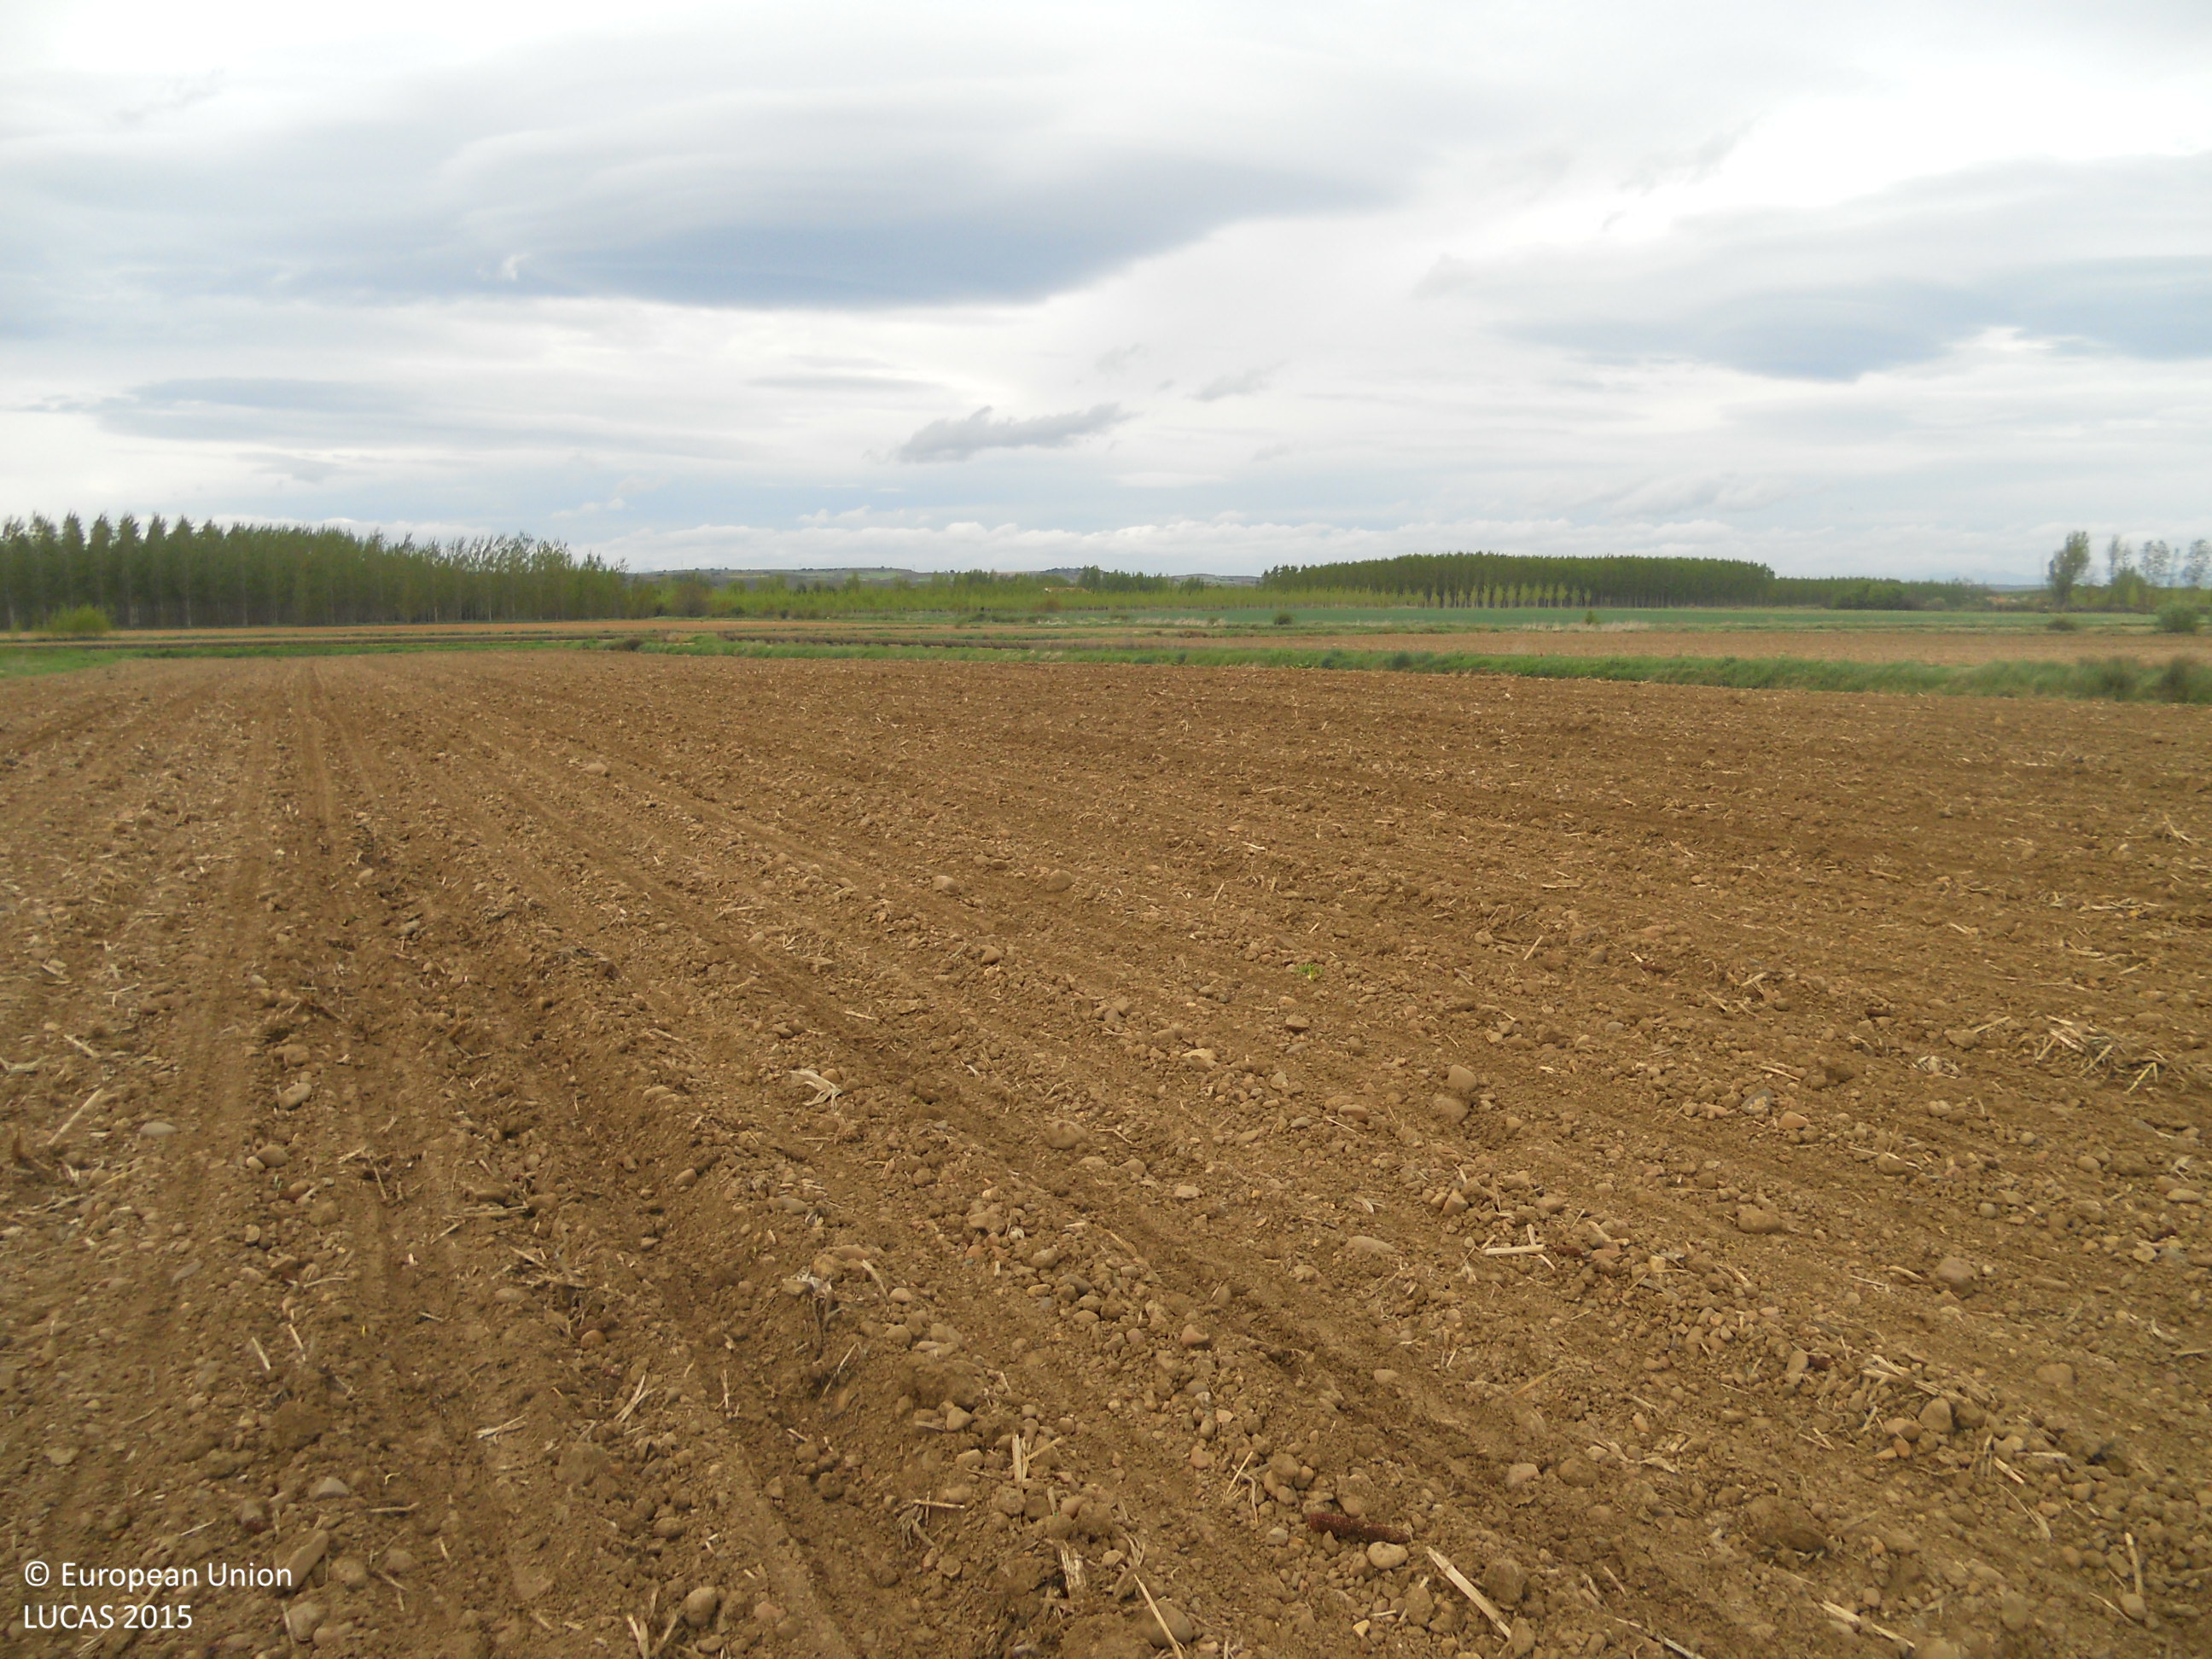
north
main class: Cropland
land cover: Maize
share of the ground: < 10 %
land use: Agriculture (excluding fallow land and kitchen gardens)
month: May
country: ES
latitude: 42.5263
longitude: -5.3203
